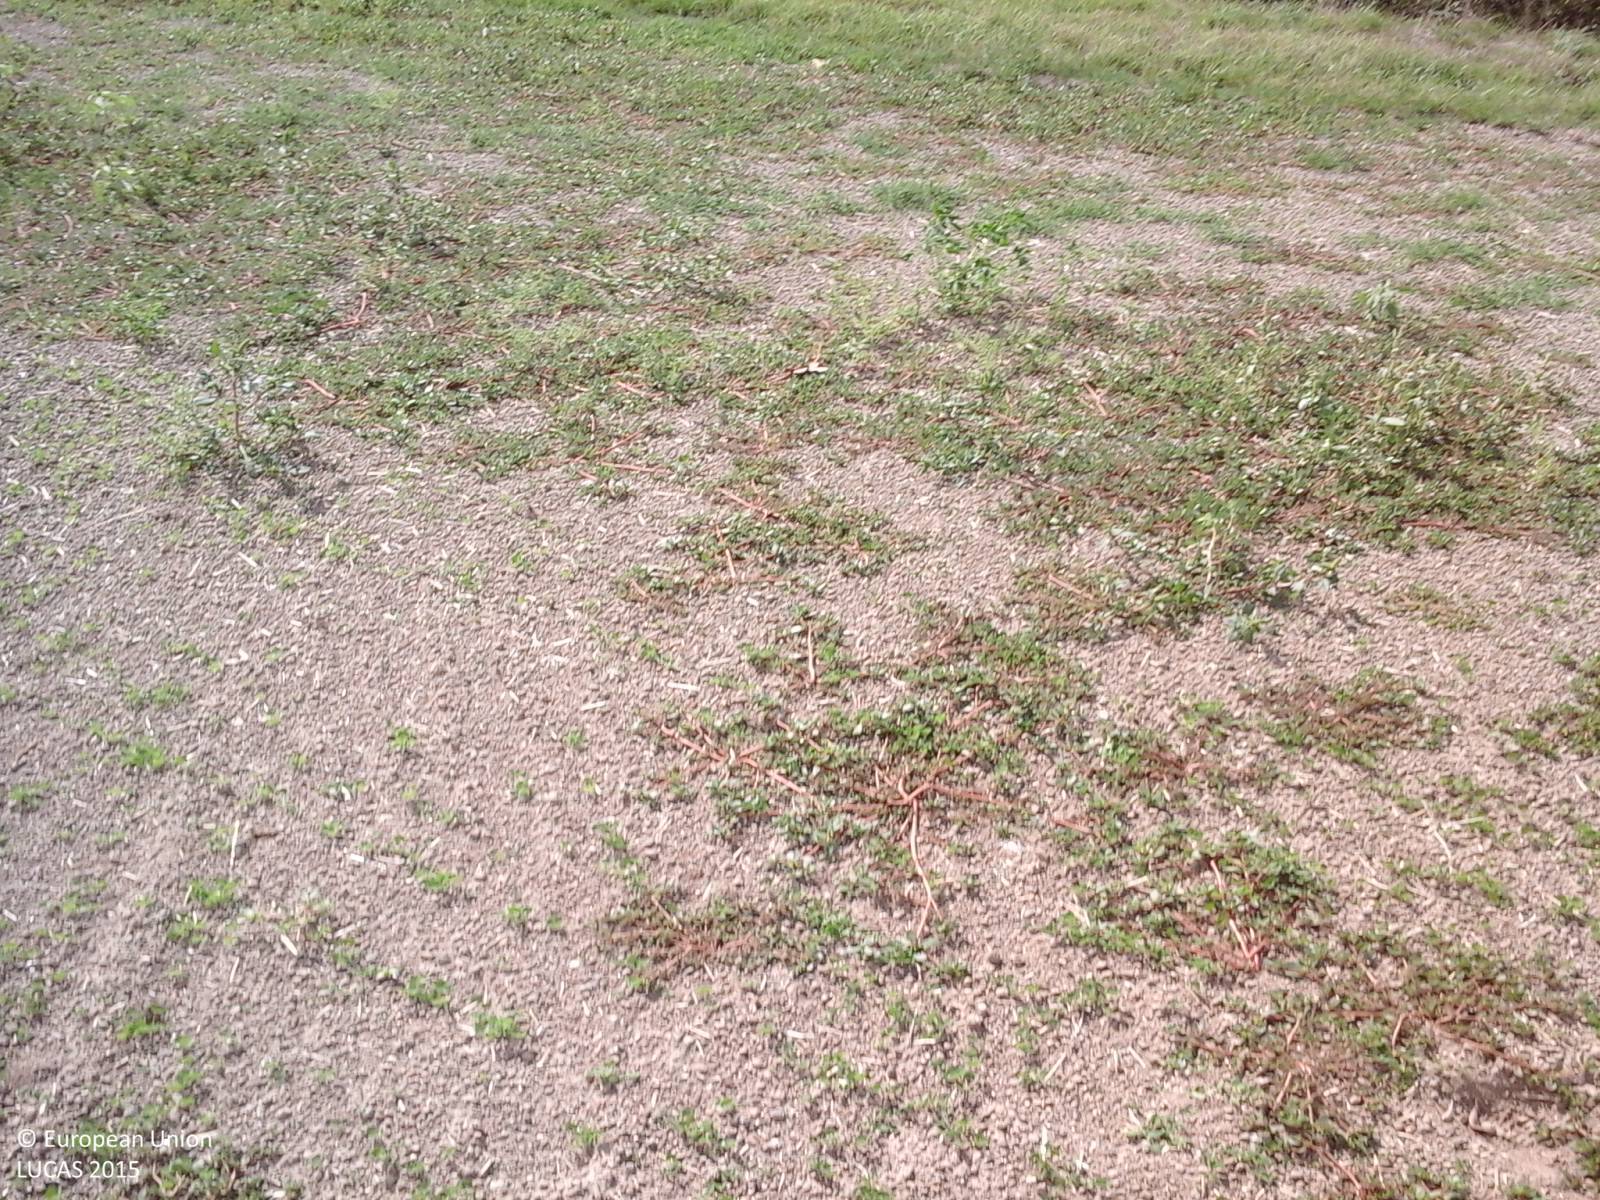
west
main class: Cropland
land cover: Clovers
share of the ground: < 10 %
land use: Agriculture (excluding fallow land and kitchen gardens)
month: September
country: IT
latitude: 42.3351
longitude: 12.4553
